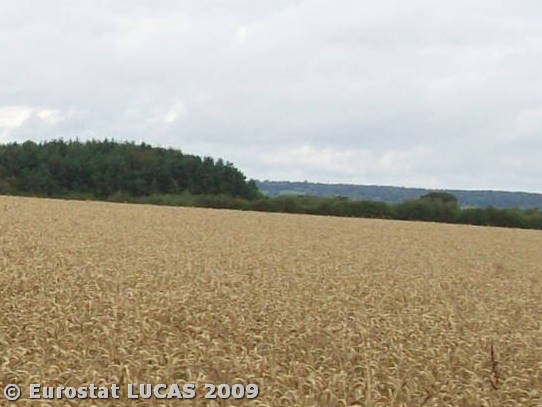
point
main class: Cropland
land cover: Common wheat
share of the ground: > 75 %
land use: Agriculture (excluding fallow land and kitchen gardens)
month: September
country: GB
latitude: 52.5302
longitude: -2.5227
